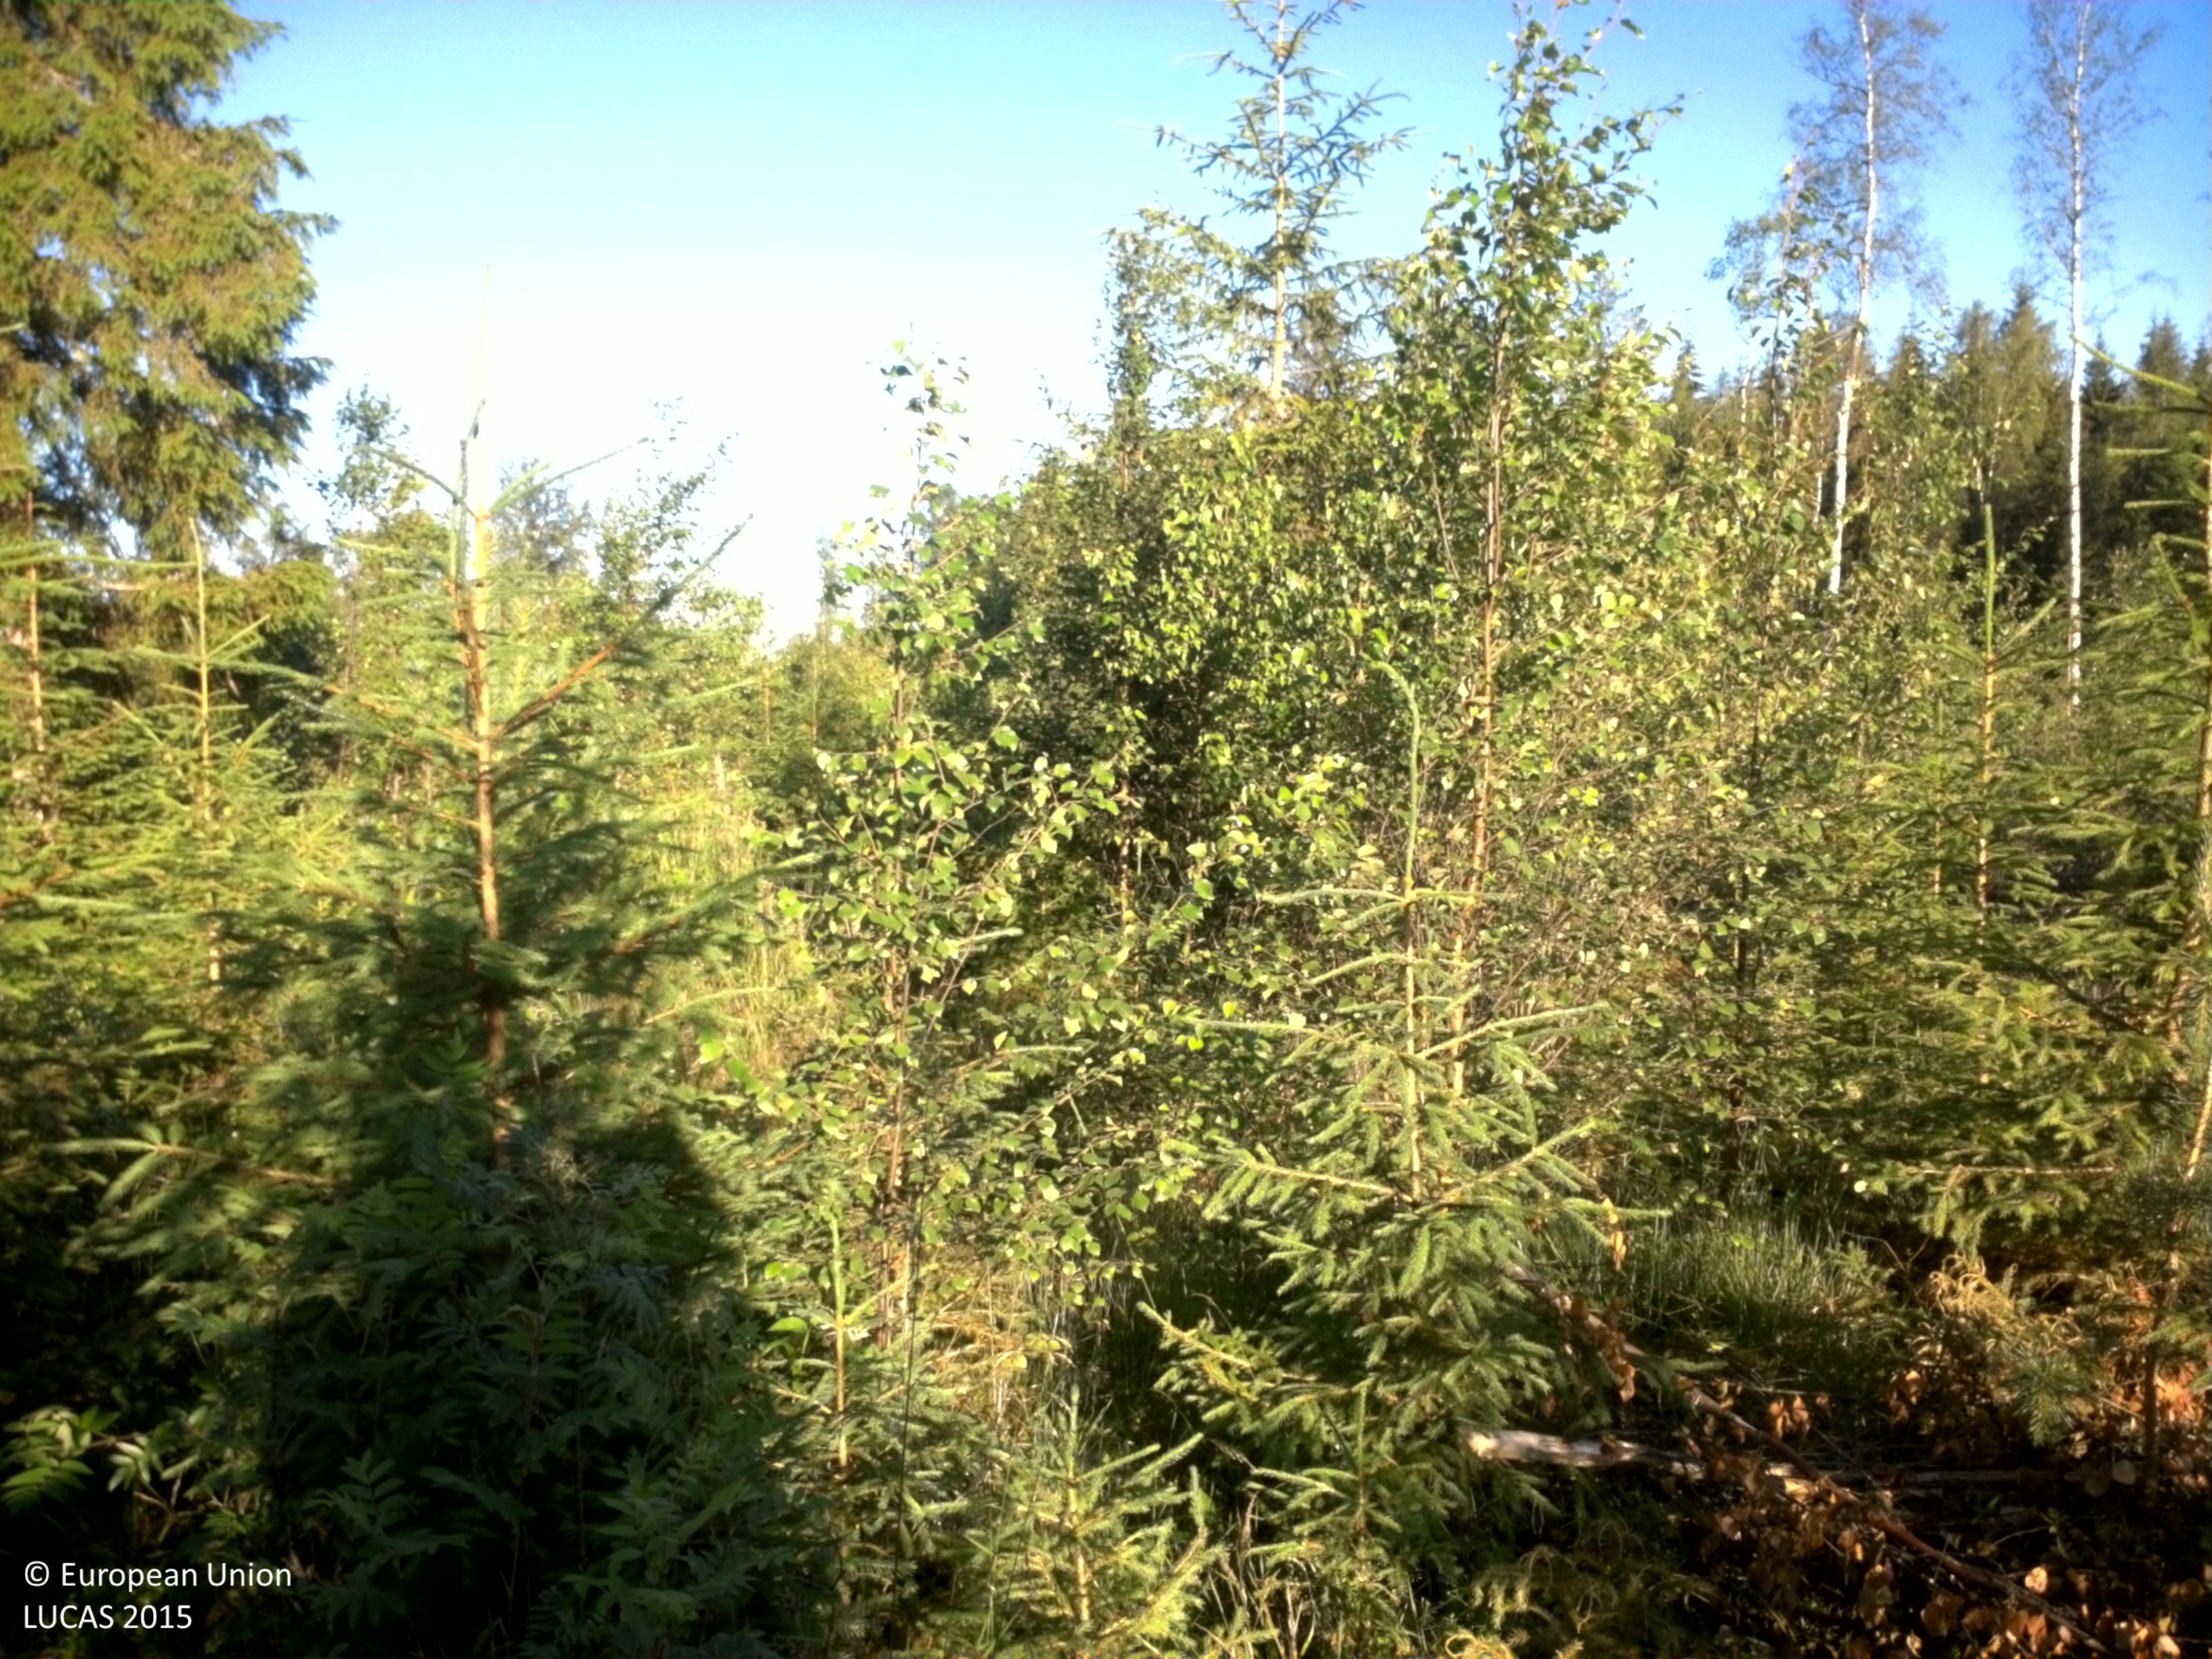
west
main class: Woodland
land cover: Spruce dominated mixed woodland
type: boreal forest
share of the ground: 25 - 50 %
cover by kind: coniferous forest trees 35 %, herbaceous plants 30 %, broadleaved forest trees 15 %, shrubs 5 %
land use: Forestry
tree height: < 5 m
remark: Clear cut
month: July
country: SE
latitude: 59.8720
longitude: 12.4046
